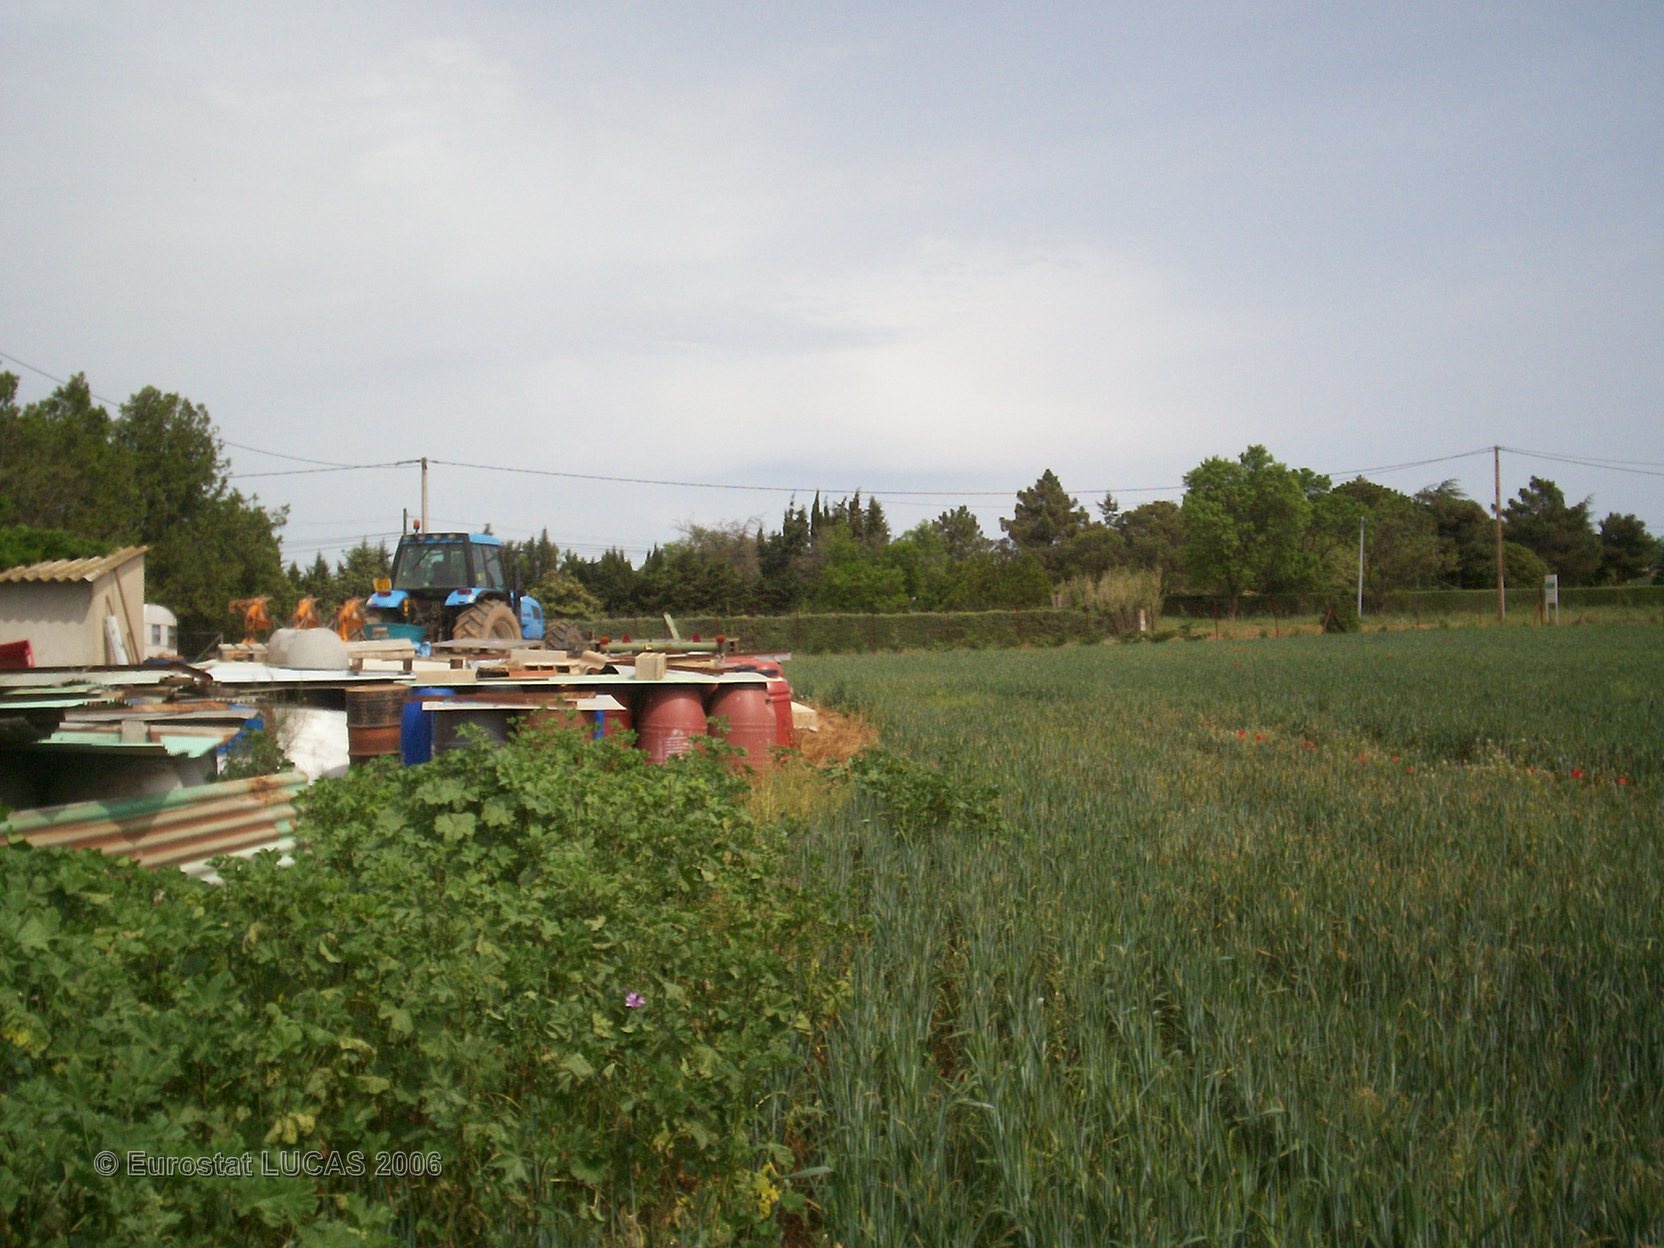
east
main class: Cropland
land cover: Common wheat
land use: Agriculture (excluding fallow land and kitchen gardens)
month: April
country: FR
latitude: 43.4018
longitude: 3.4530
